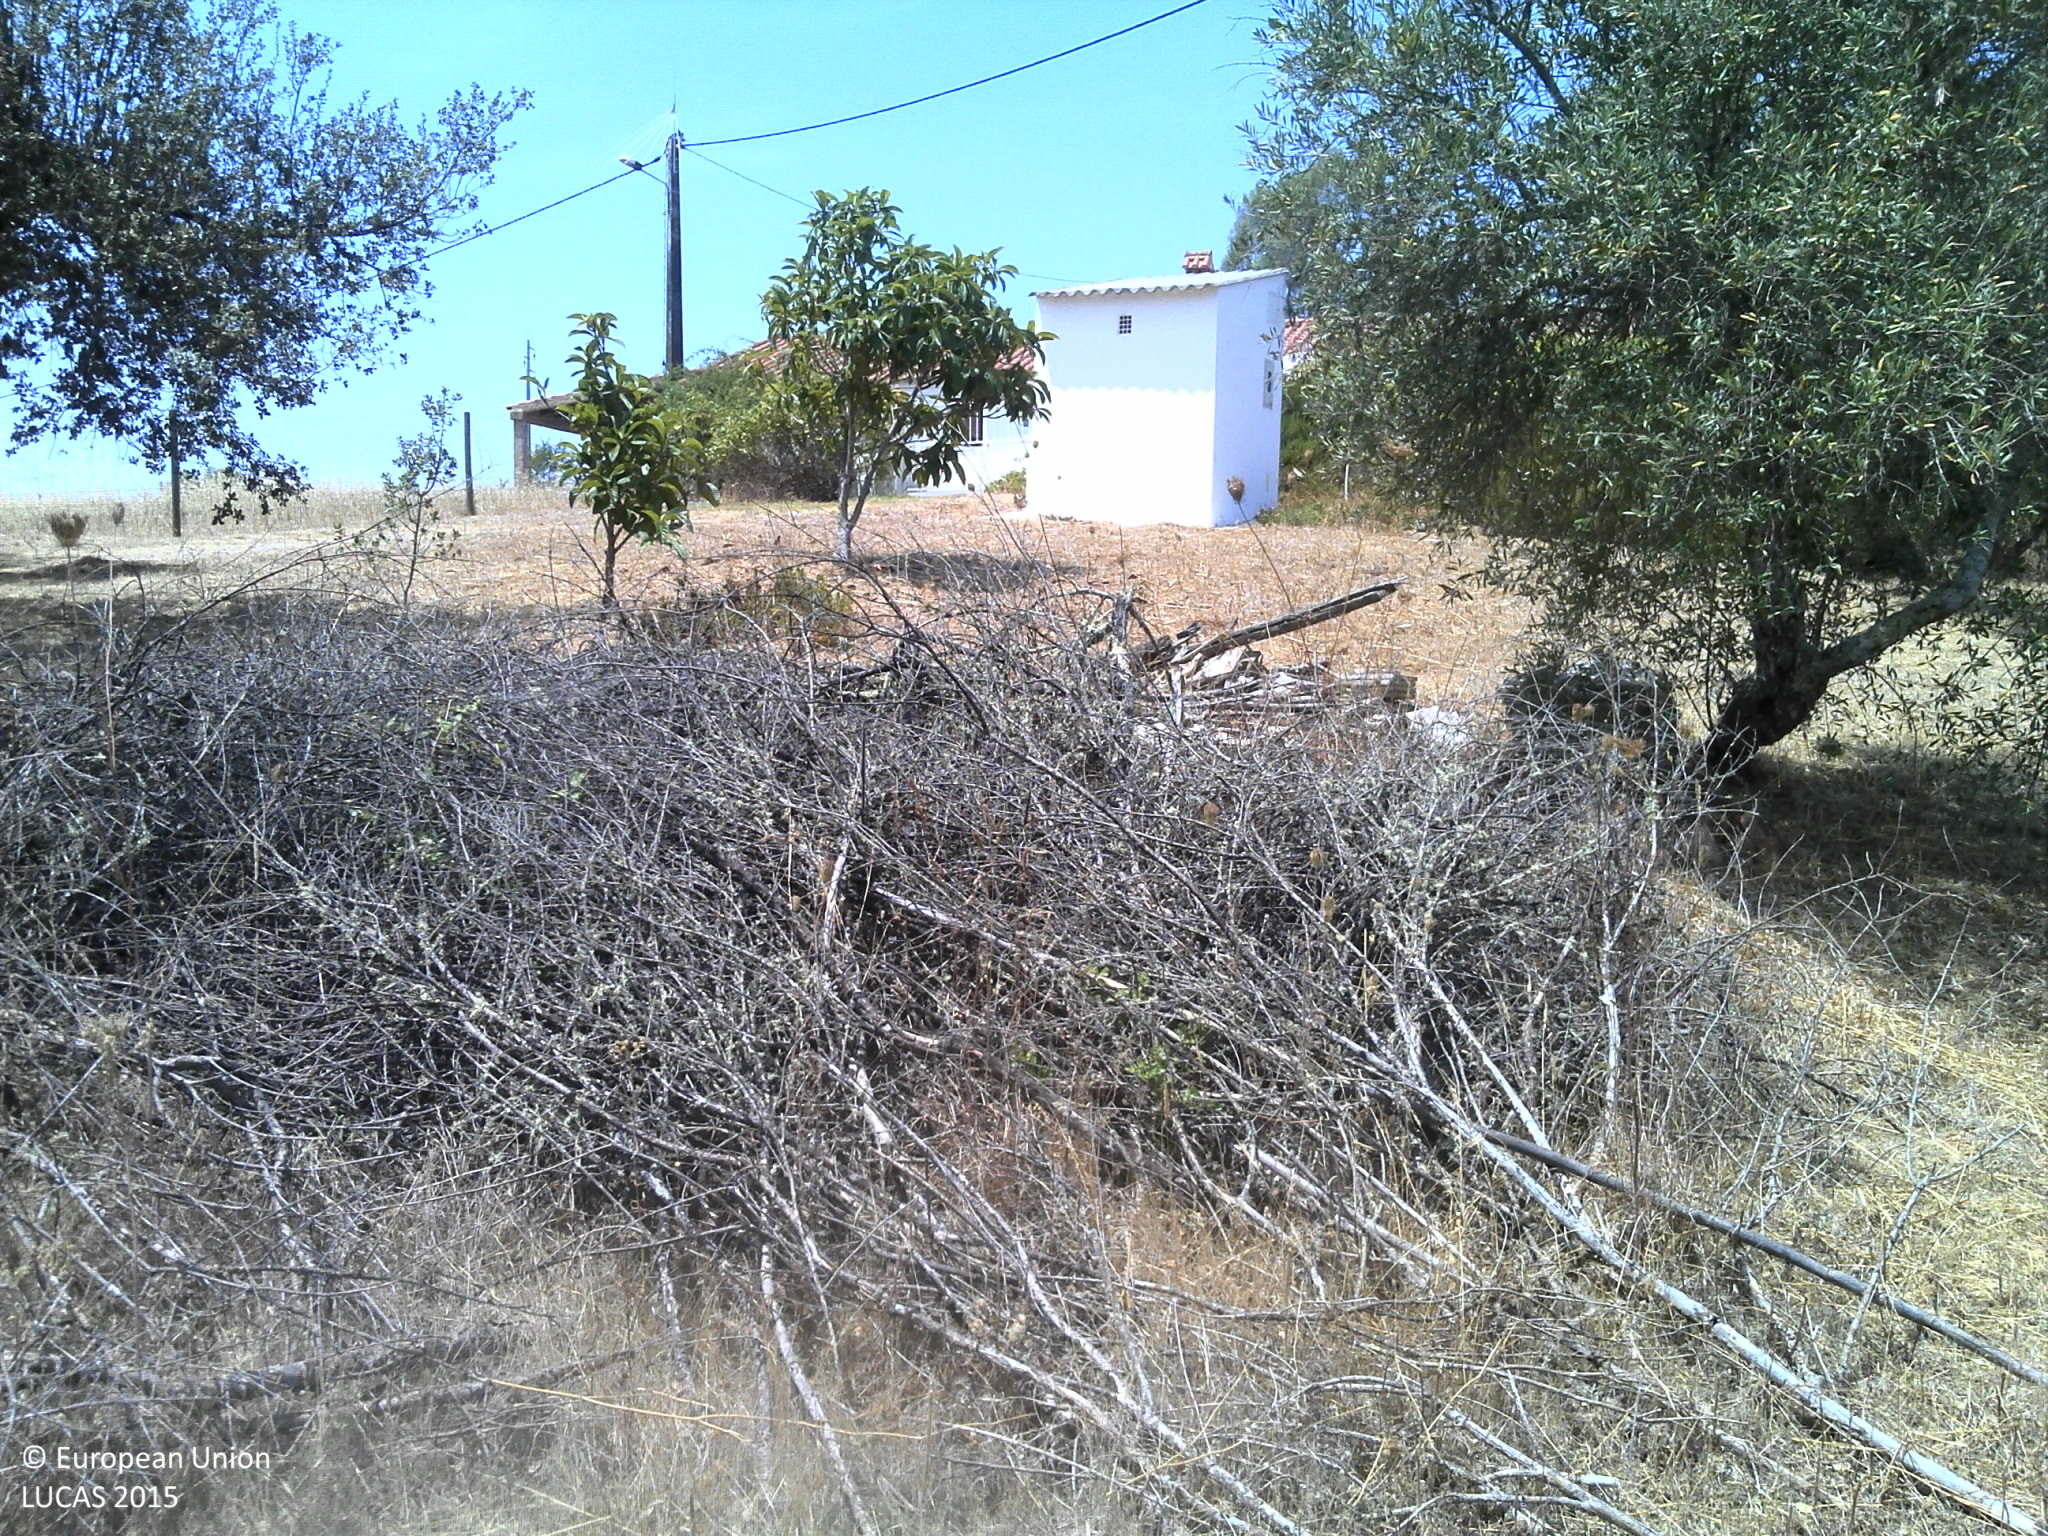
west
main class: Cropland
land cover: Olive groves
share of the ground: 10 - 25 %
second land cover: Grassland without tree/shrub cover
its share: 25 - 50 %
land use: Agriculture (excluding fallow land and kitchen gardens)
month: July
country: PT
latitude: 37.6258
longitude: -8.2833
